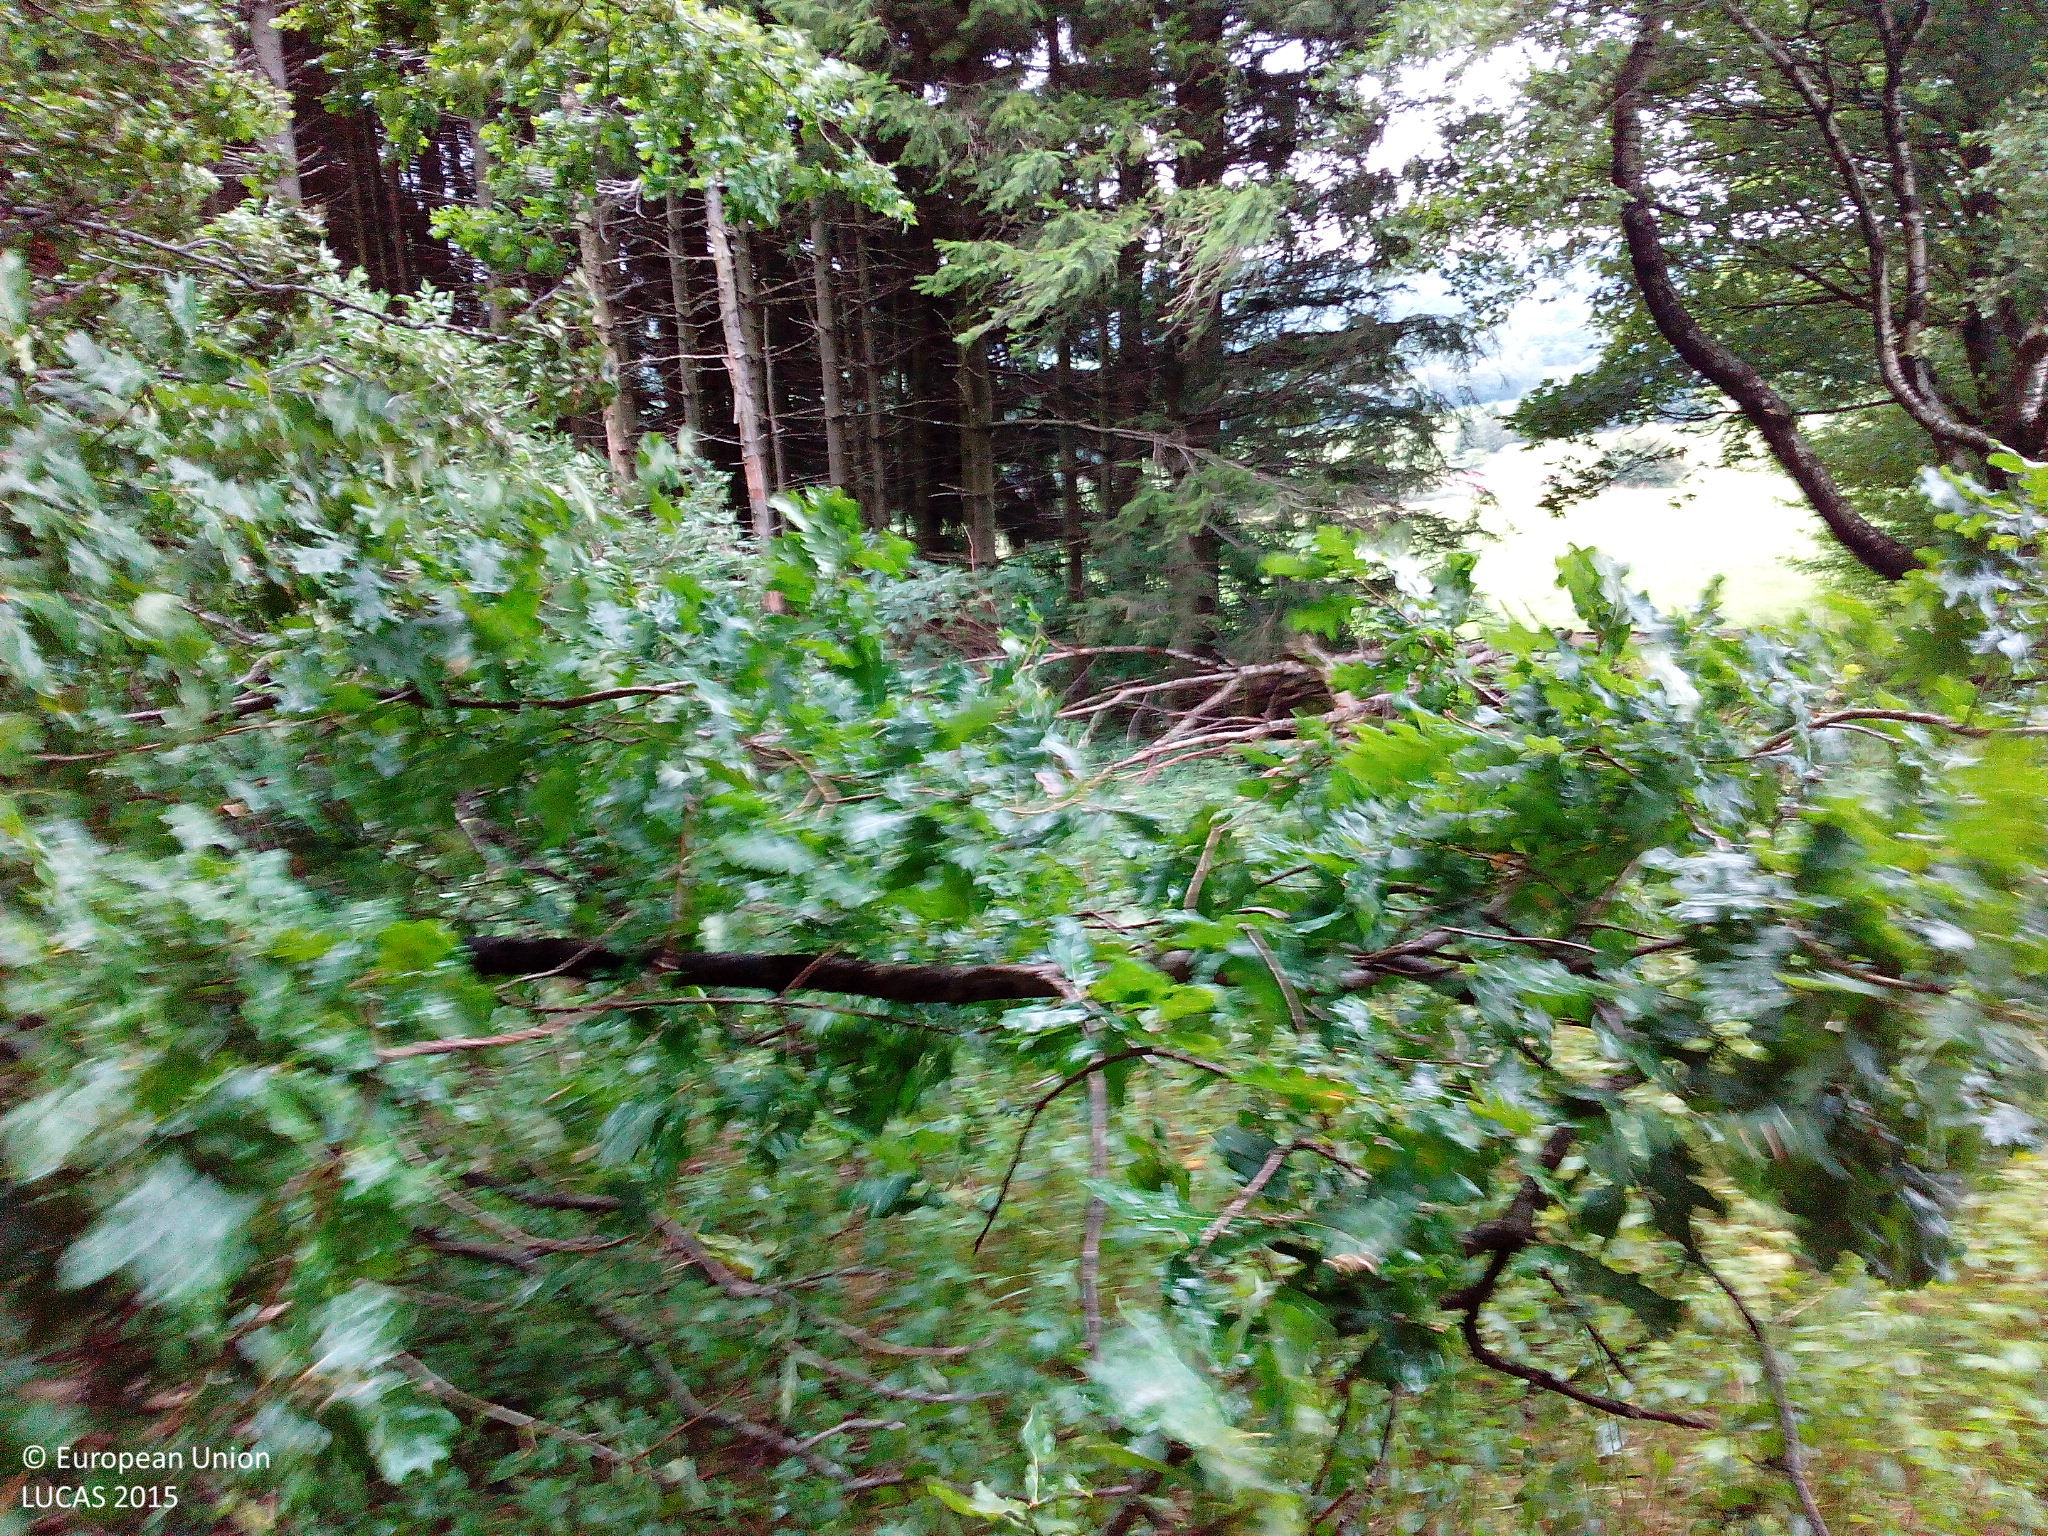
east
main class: Woodland
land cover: Spruce dominated mixed woodland
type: hemiboreal forest and nemoral coniferous forest and mixed broadleaved-coniferous forest
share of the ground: > 75 %
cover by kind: broadleaved forest trees 70 %, coniferous forest trees 30 %
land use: Forestry
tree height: > 5 m
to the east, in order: Spruce dominated mixed woodland; Spruce dominated coniferous woodland; Fences; Grassland without tree/shrub cover; Grassland with sparse tree/shrub cover; Fences; Shrubland with sparse tree cover; Tracks; Grass margins; Fences; Grassland without tree/shrub cover
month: August
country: DE
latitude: 50.5590
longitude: 9.1956
